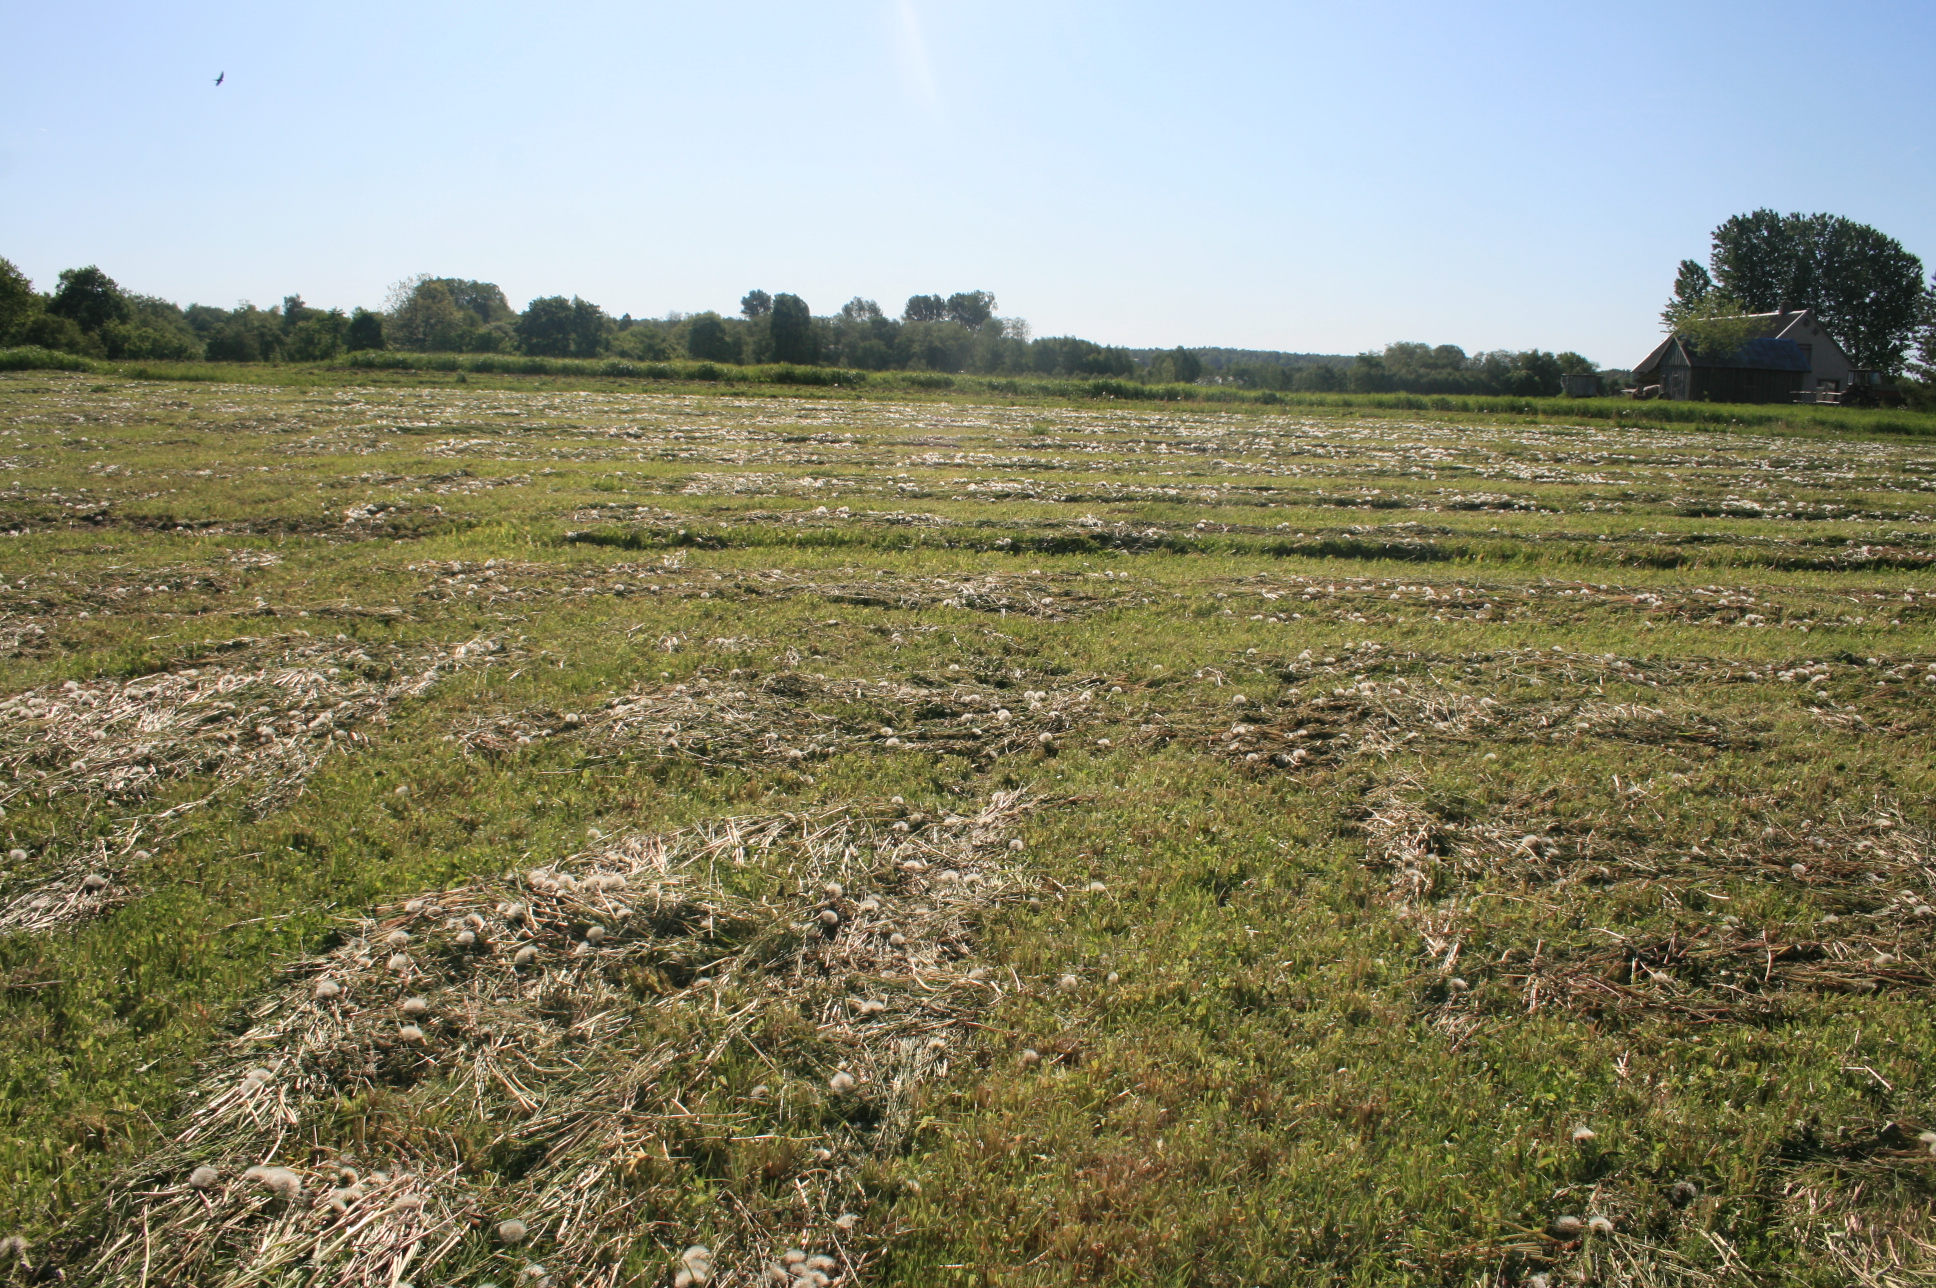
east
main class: Grassland
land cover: Grassland without tree/shrub cover
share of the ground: > 75 %
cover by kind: herbaceous plants 100 %
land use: Agriculture (excluding fallow land and kitchen gardens)
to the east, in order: Grassland without tree/shrub cover; Potatoes; Other leguminous and mixtures for fodder; Potatoes; Other leguminous and mixtures for fodder; Grassland without tree/shrub cover; Broadleaved woodland
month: June
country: LT
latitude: 55.8777
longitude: 21.9919
